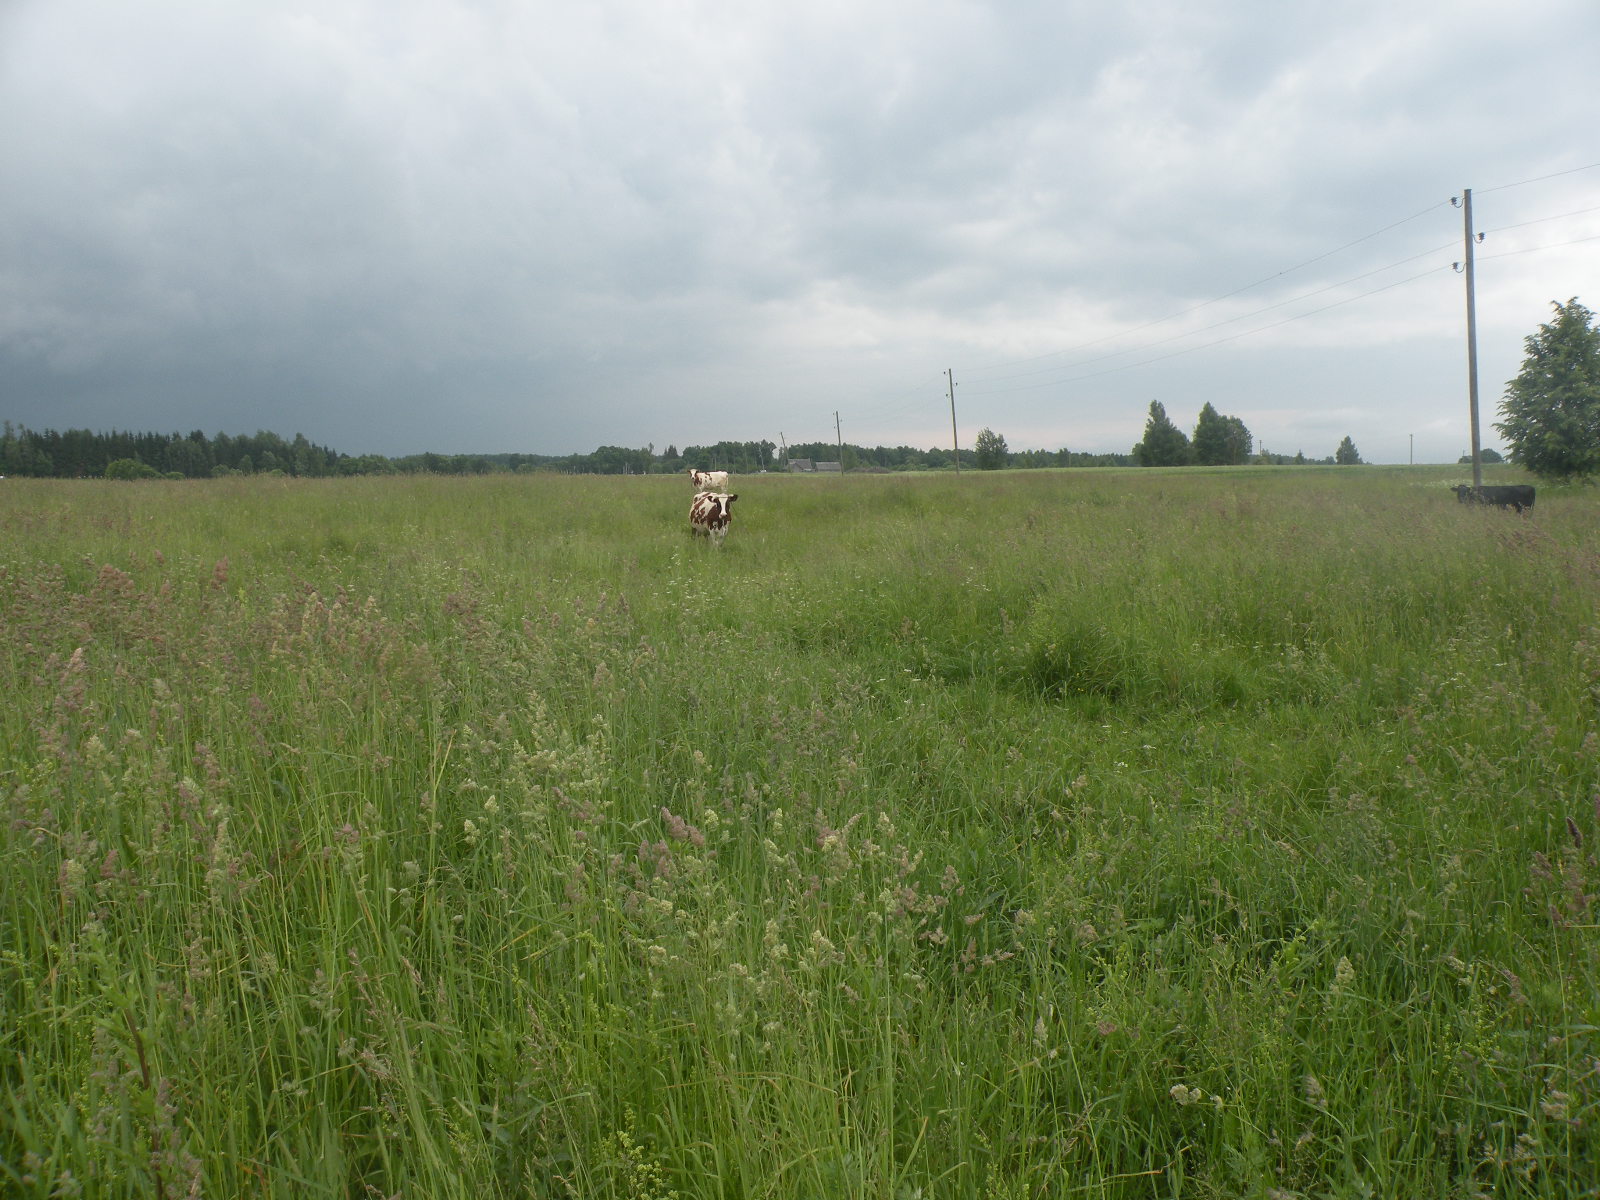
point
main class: Grassland
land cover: Grassland without tree/shrub cover
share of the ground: > 75 %
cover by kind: herbaceous plants 100 %
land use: Agriculture (excluding fallow land and kitchen gardens)
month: June
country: LV
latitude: 56.0425
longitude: 26.6730
